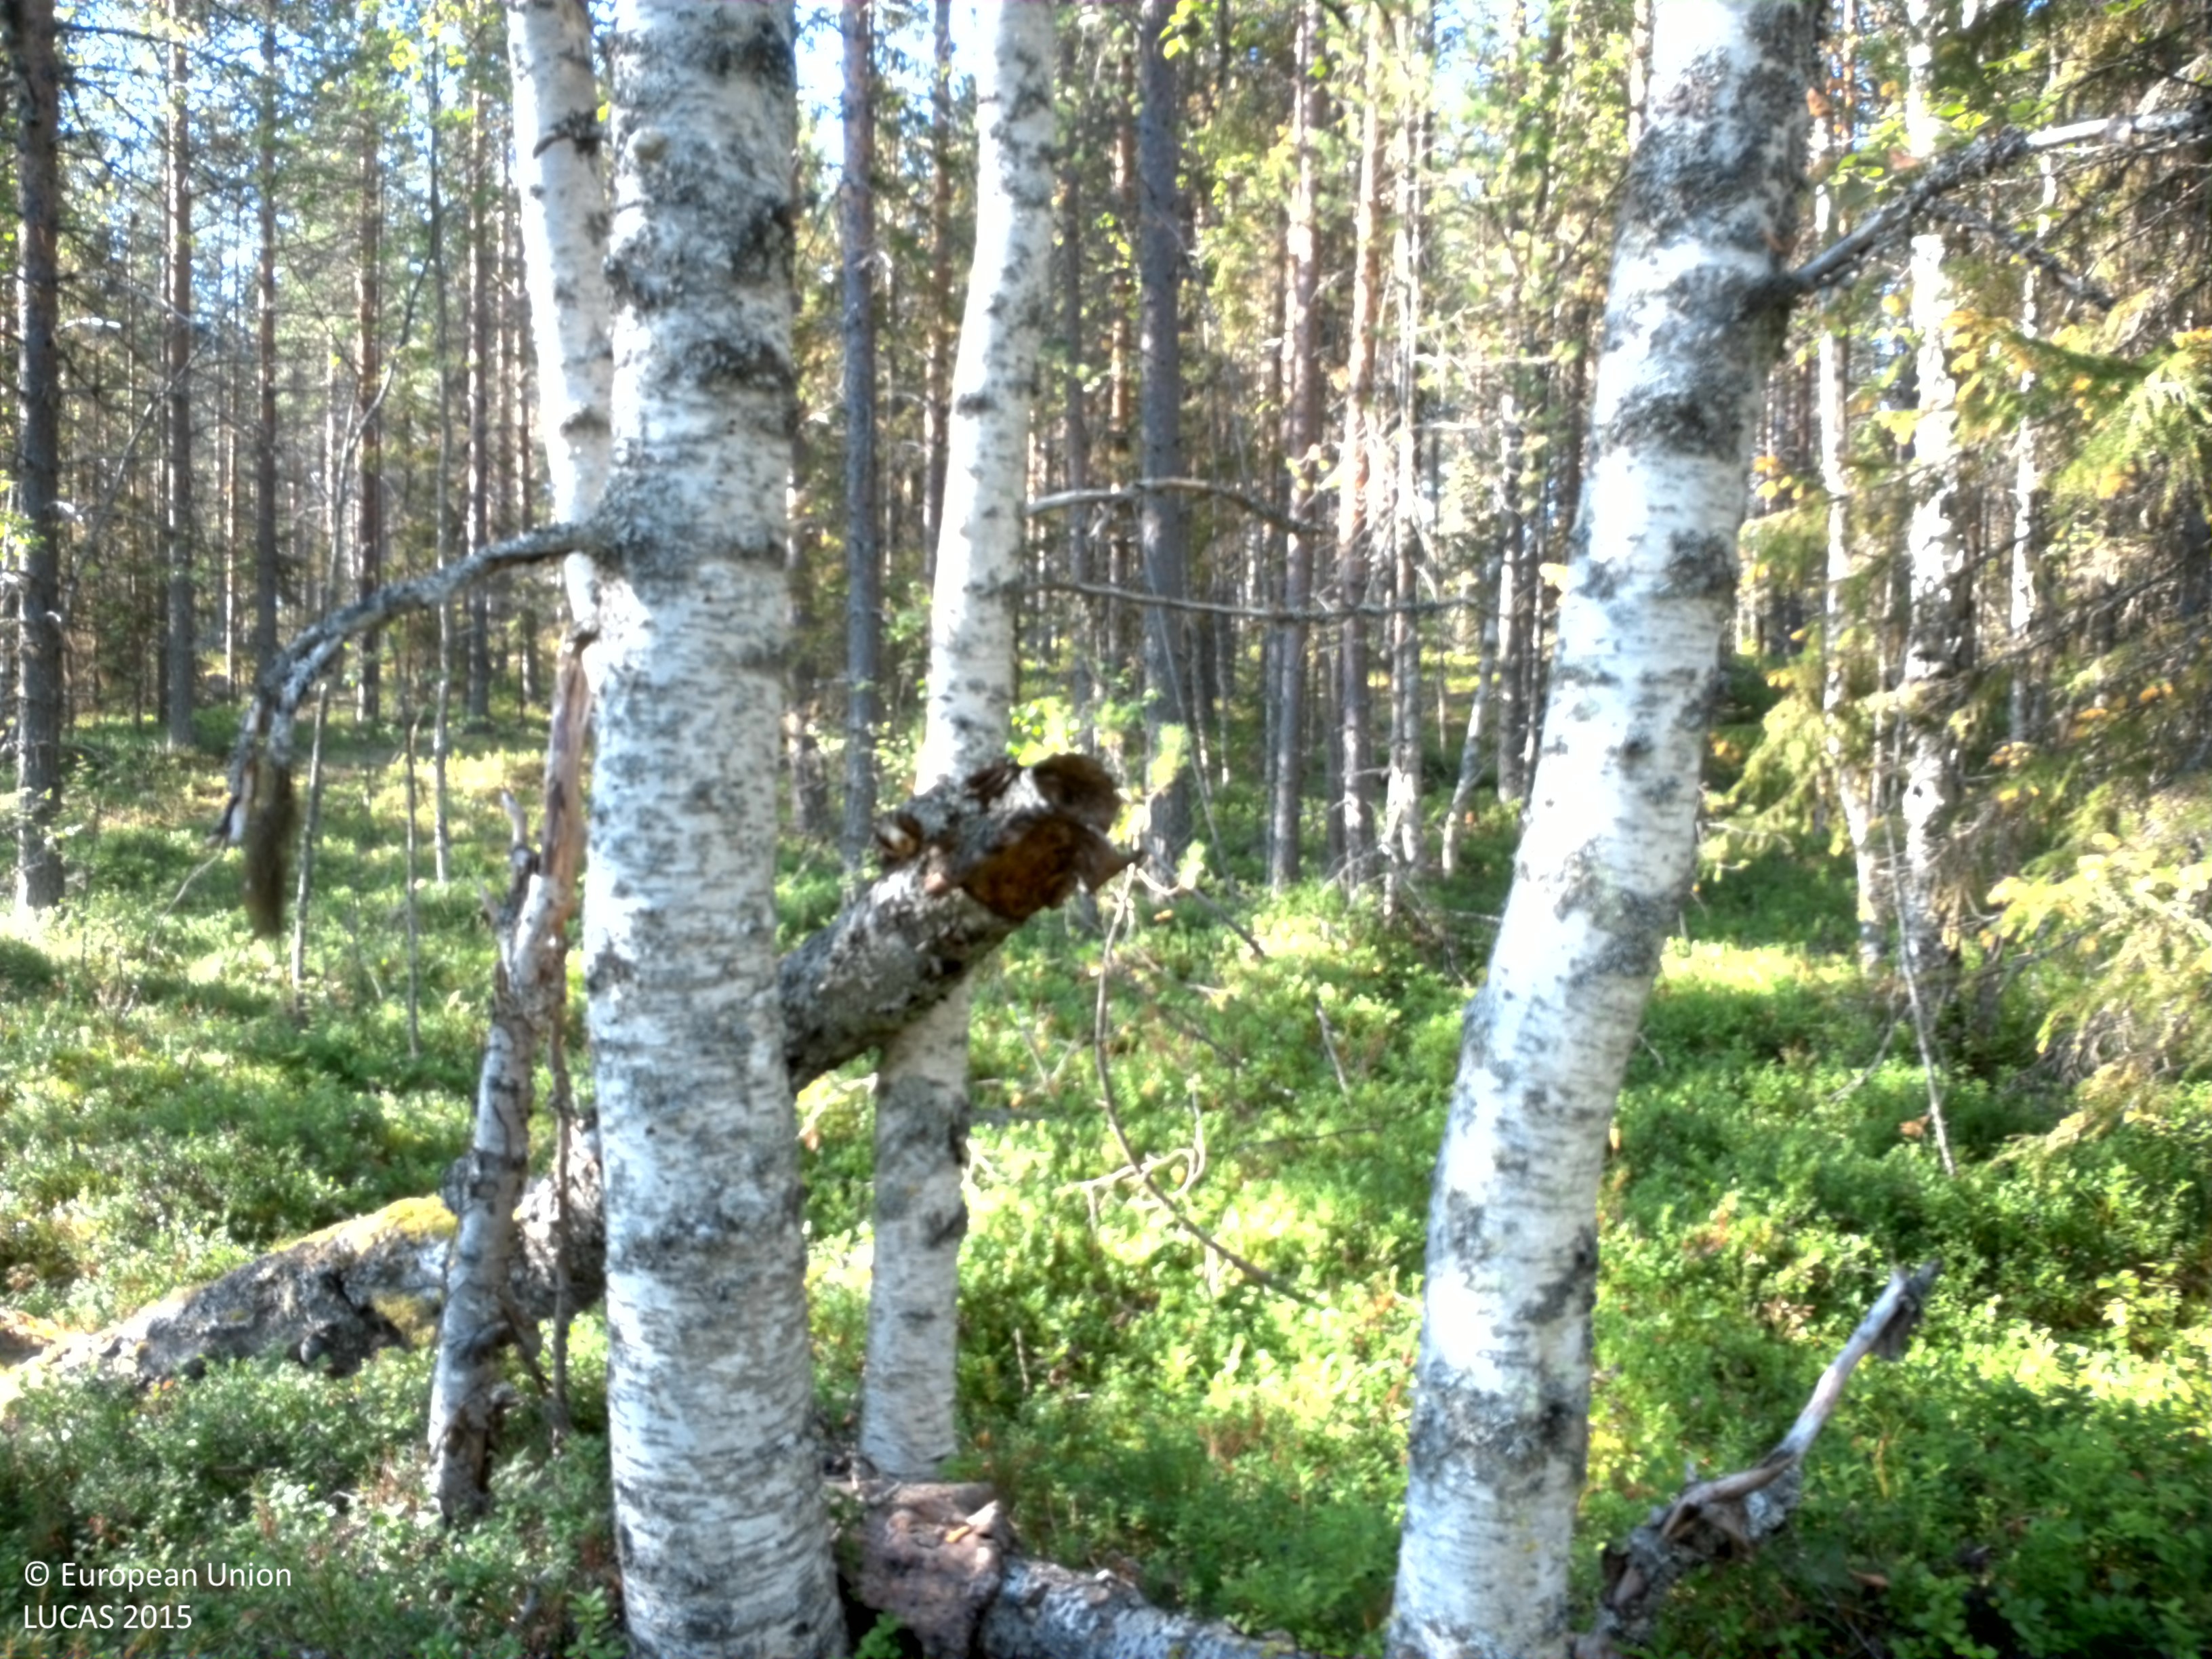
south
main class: Woodland
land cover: Pine dominated mixed woodland
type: boreal forest
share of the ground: 50 - 75 %
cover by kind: coniferous forest trees 45 %, shrubs 35 %, broadleaved forest trees 15 %, lichens and mosses 5 %
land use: Forestry
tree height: > 5 m
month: August
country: SE
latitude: 64.5497
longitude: 18.8746
